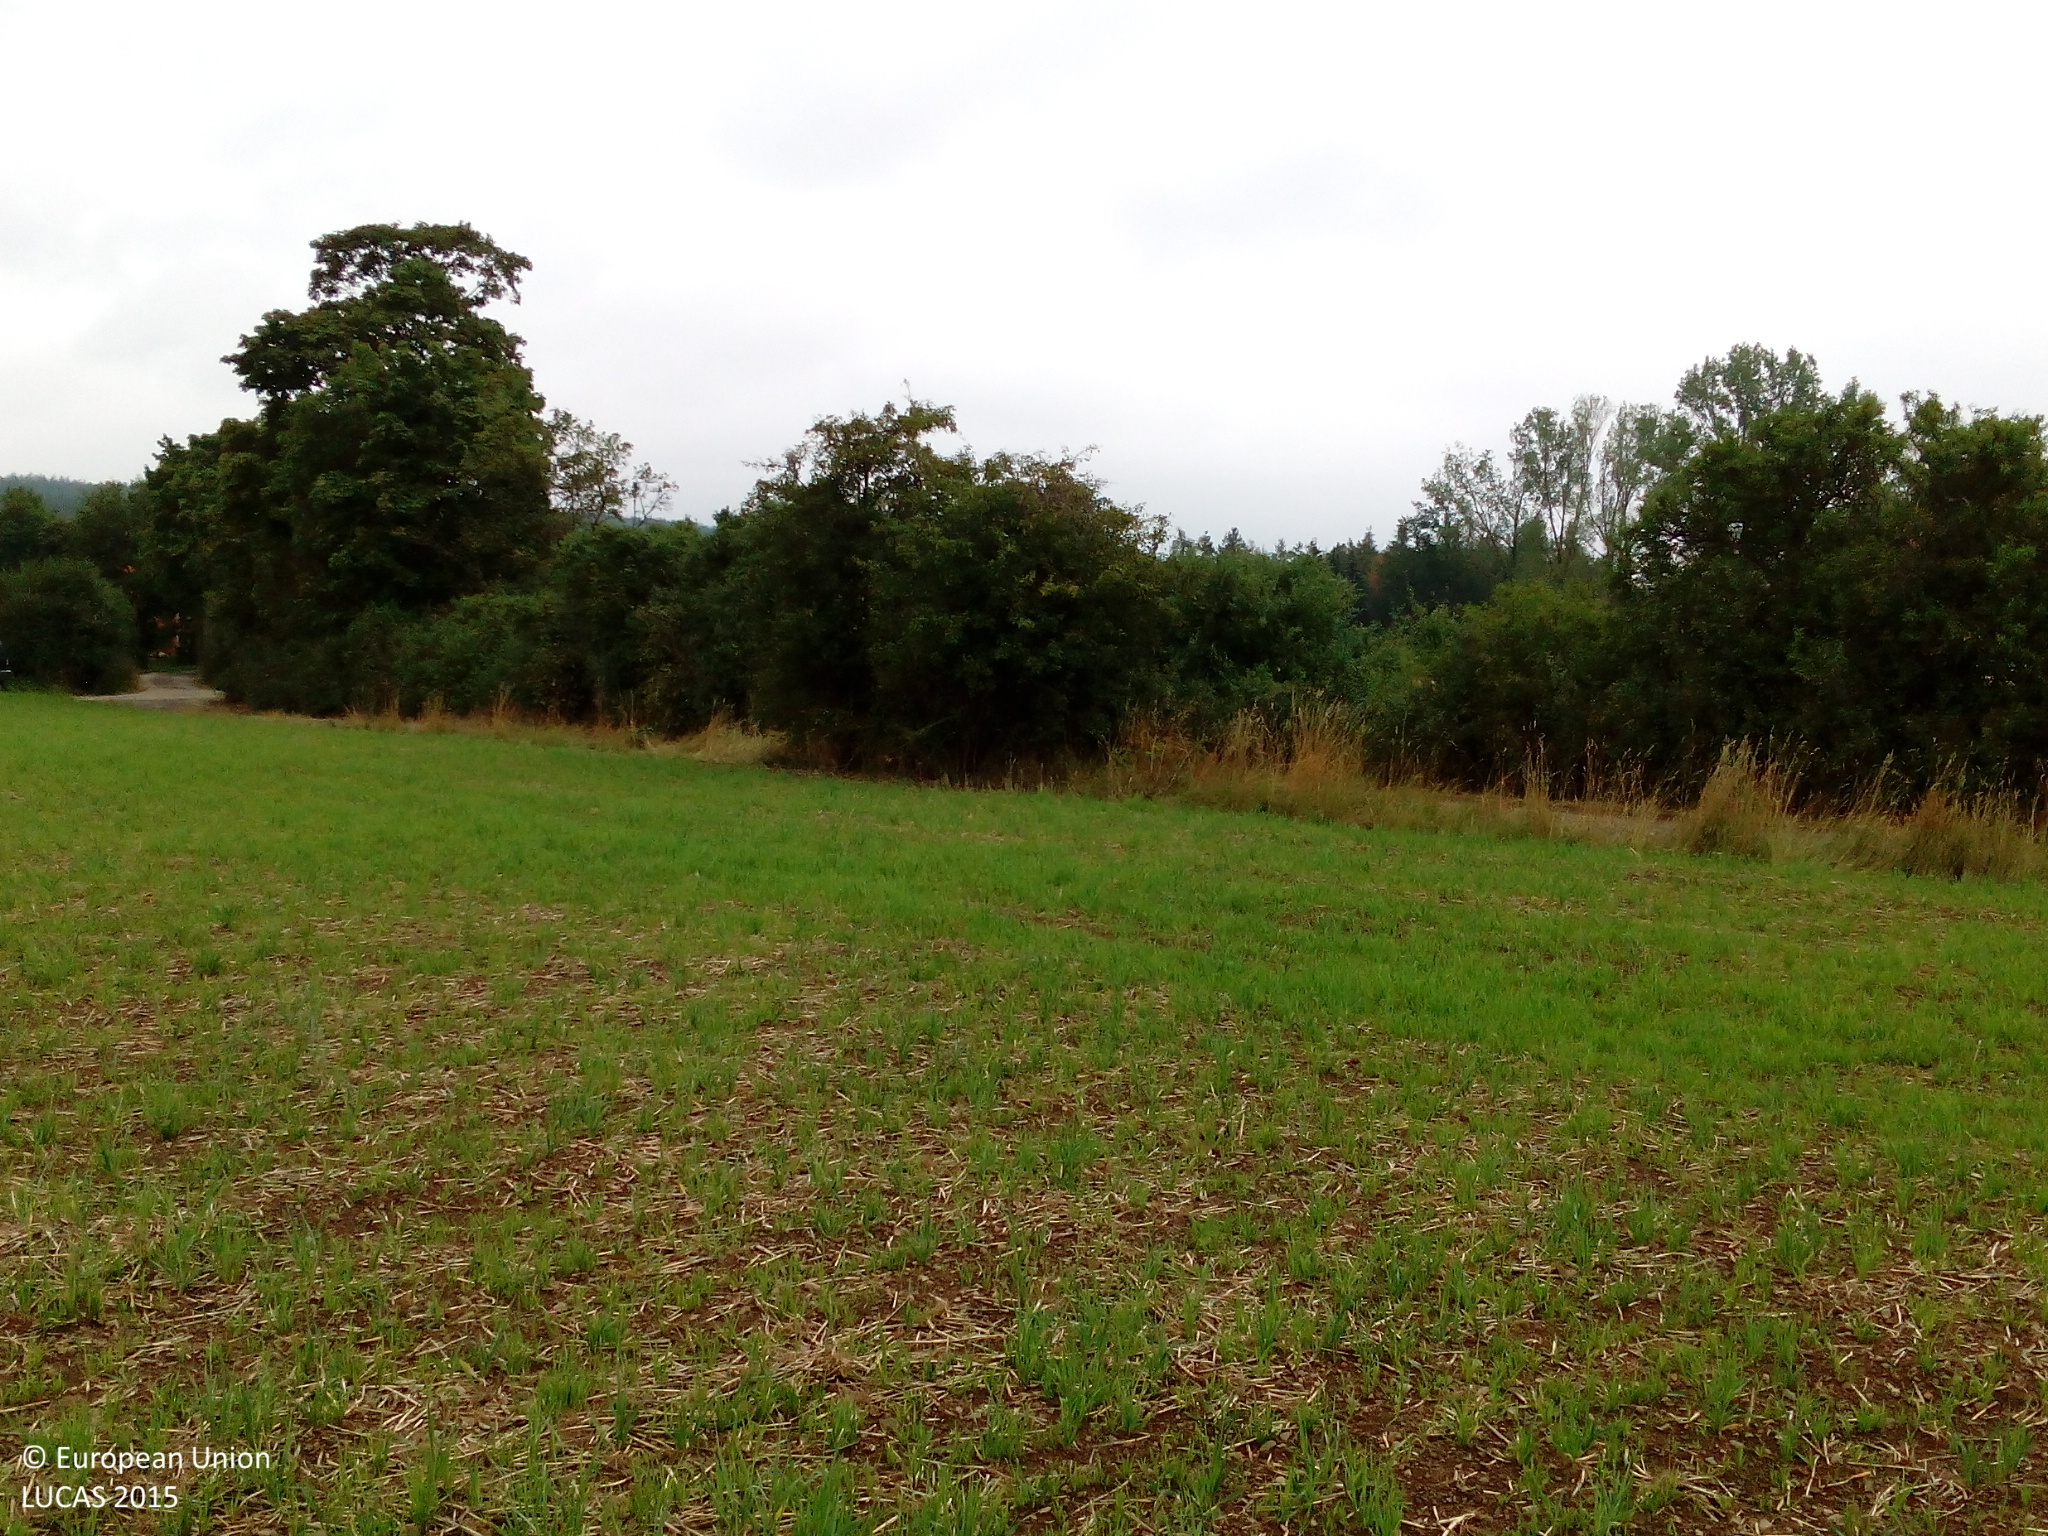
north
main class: Cropland
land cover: Common wheat
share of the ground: 25 - 50 %
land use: Agriculture (excluding fallow land and kitchen gardens)
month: August
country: DE
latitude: 50.3110
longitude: 11.9796
